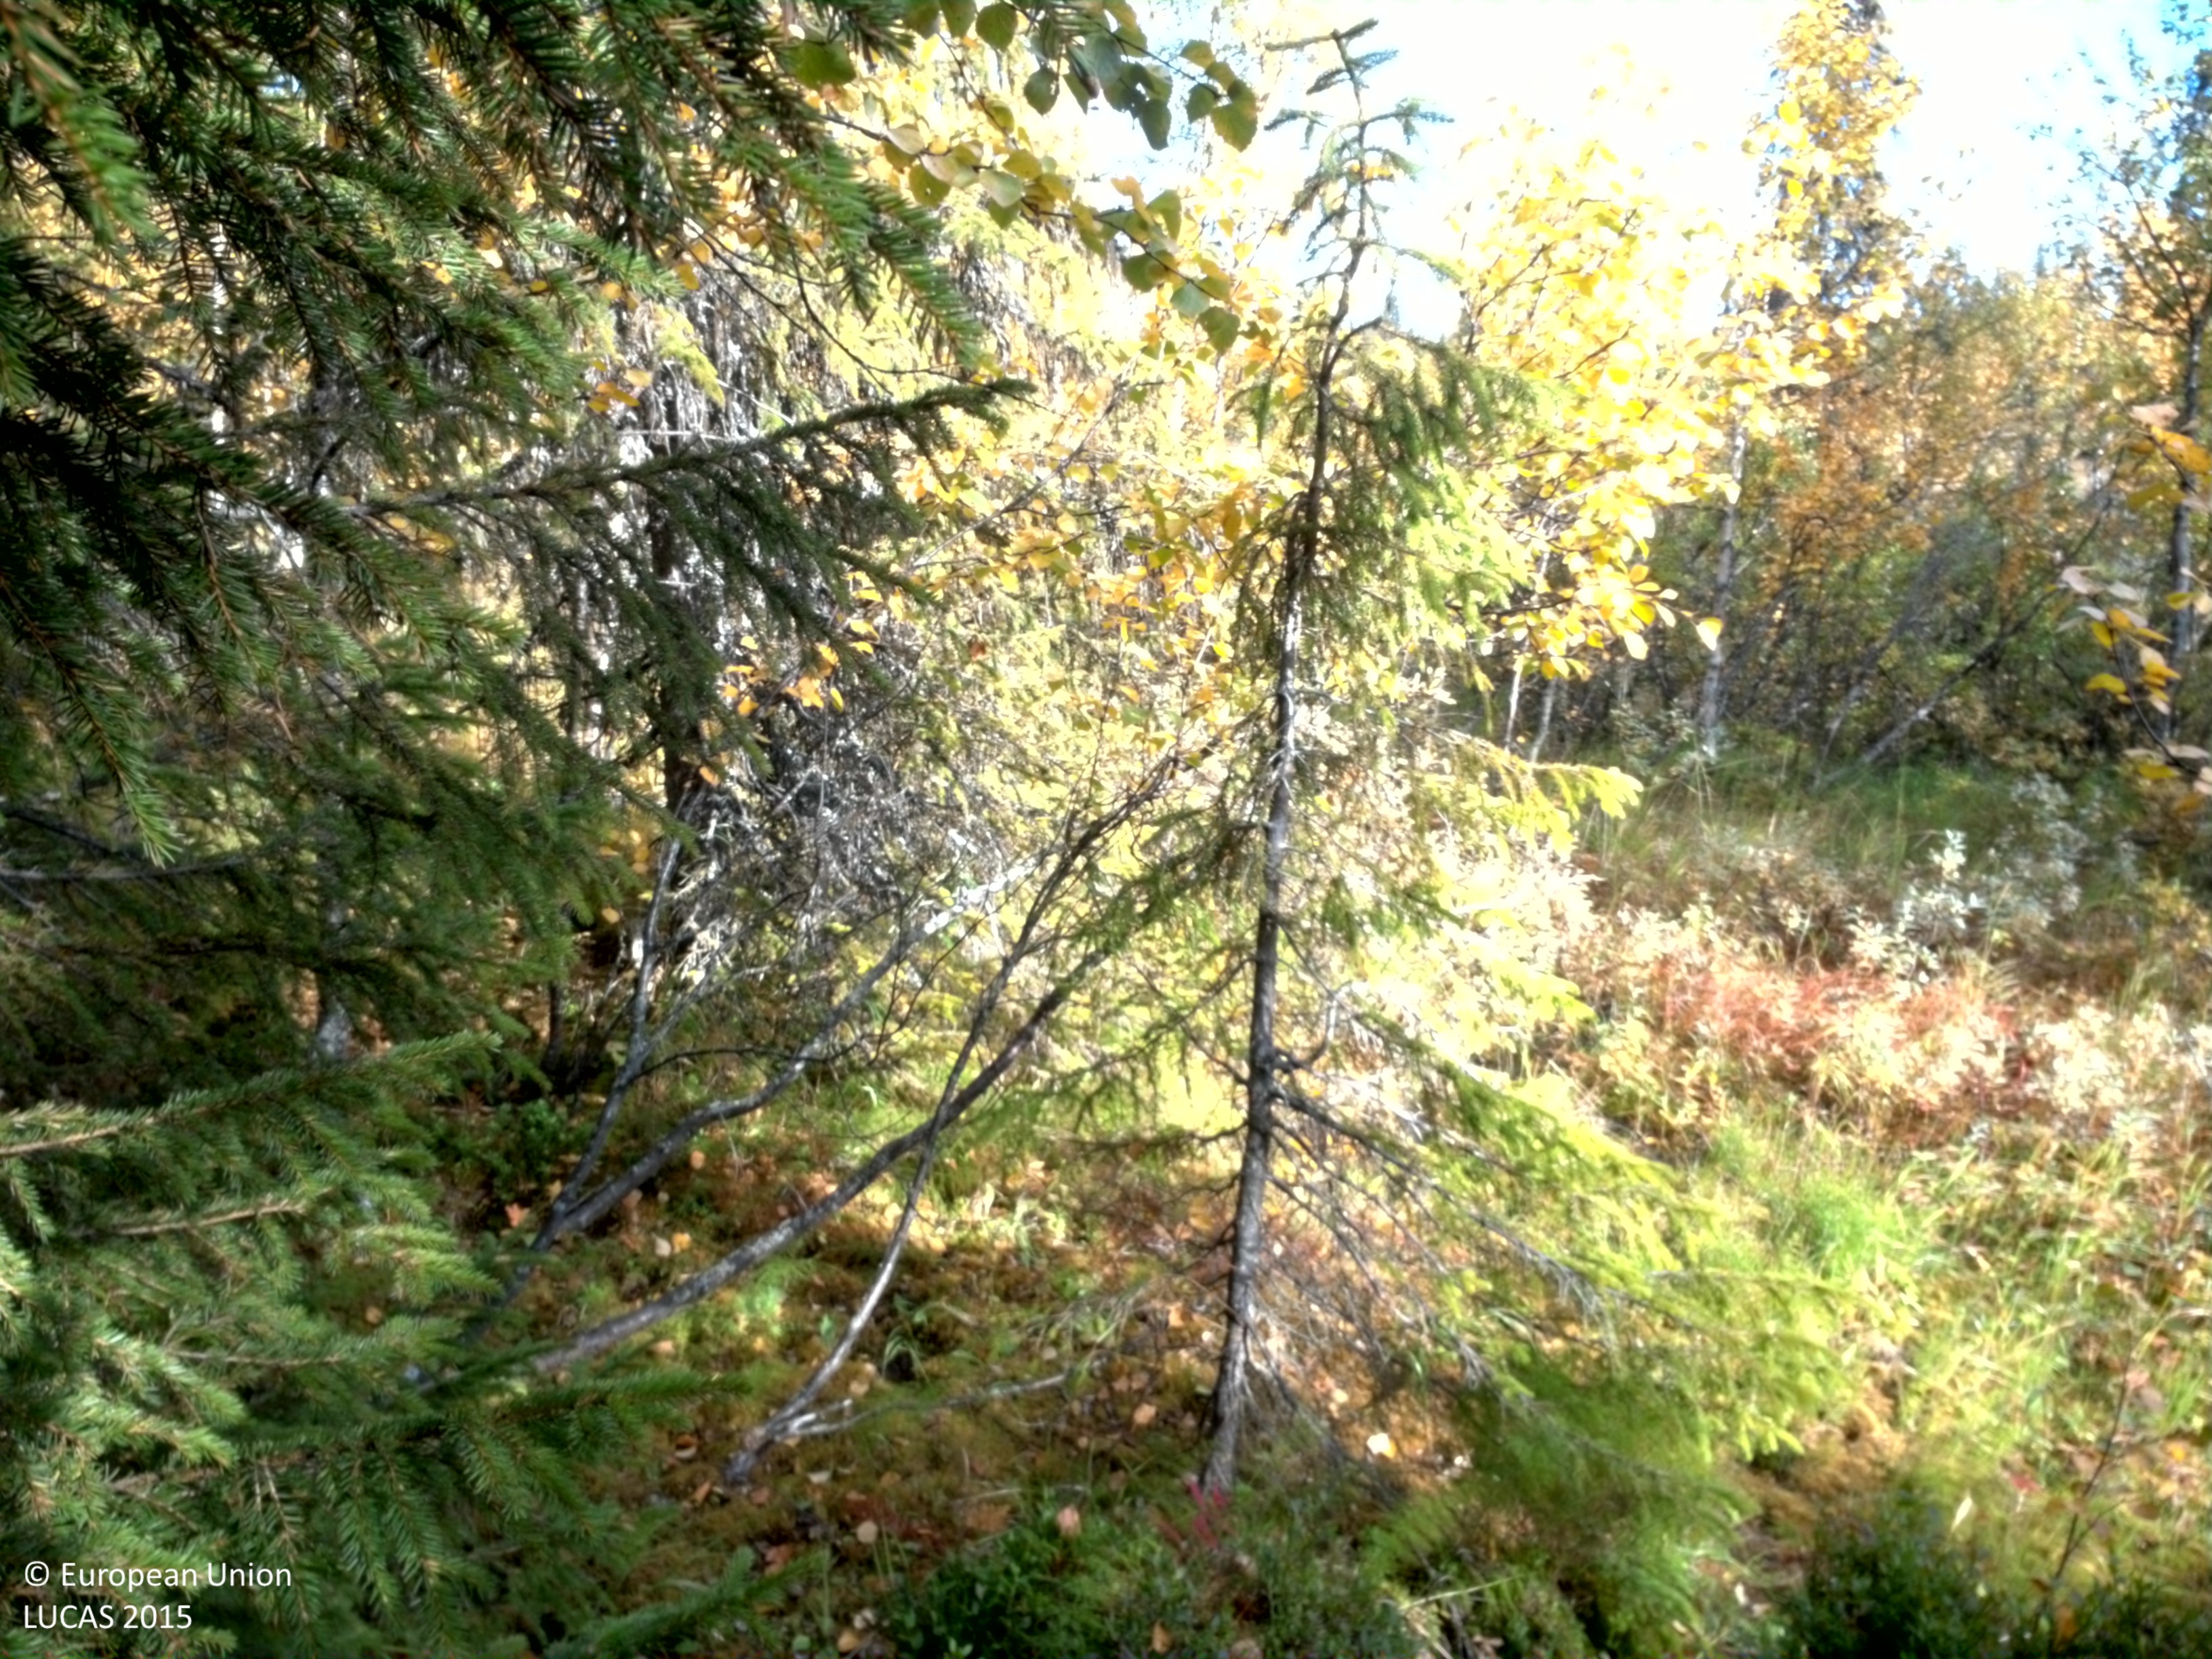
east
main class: Woodland
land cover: Spruce dominated mixed woodland
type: boreal forest
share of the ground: 25 - 50 %
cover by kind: shrubs 40 %, coniferous forest trees 20 %, broadleaved forest trees 15 %, herbaceous plants 15 %, lichens and mosses 10 %
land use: Forestry
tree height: > 5 m
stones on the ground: < 10 %
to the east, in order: Spruce dominated mixed woodland; Shrubland with sparse tree cover; Spruce dominated mixed woodland; Broadleaved woodland; Rivers and streams; Broadleaved woodland; Spruce dominated mixed woodland; Shrubland with sparse tree cover
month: September
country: SE
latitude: 65.2828
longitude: 16.8851
